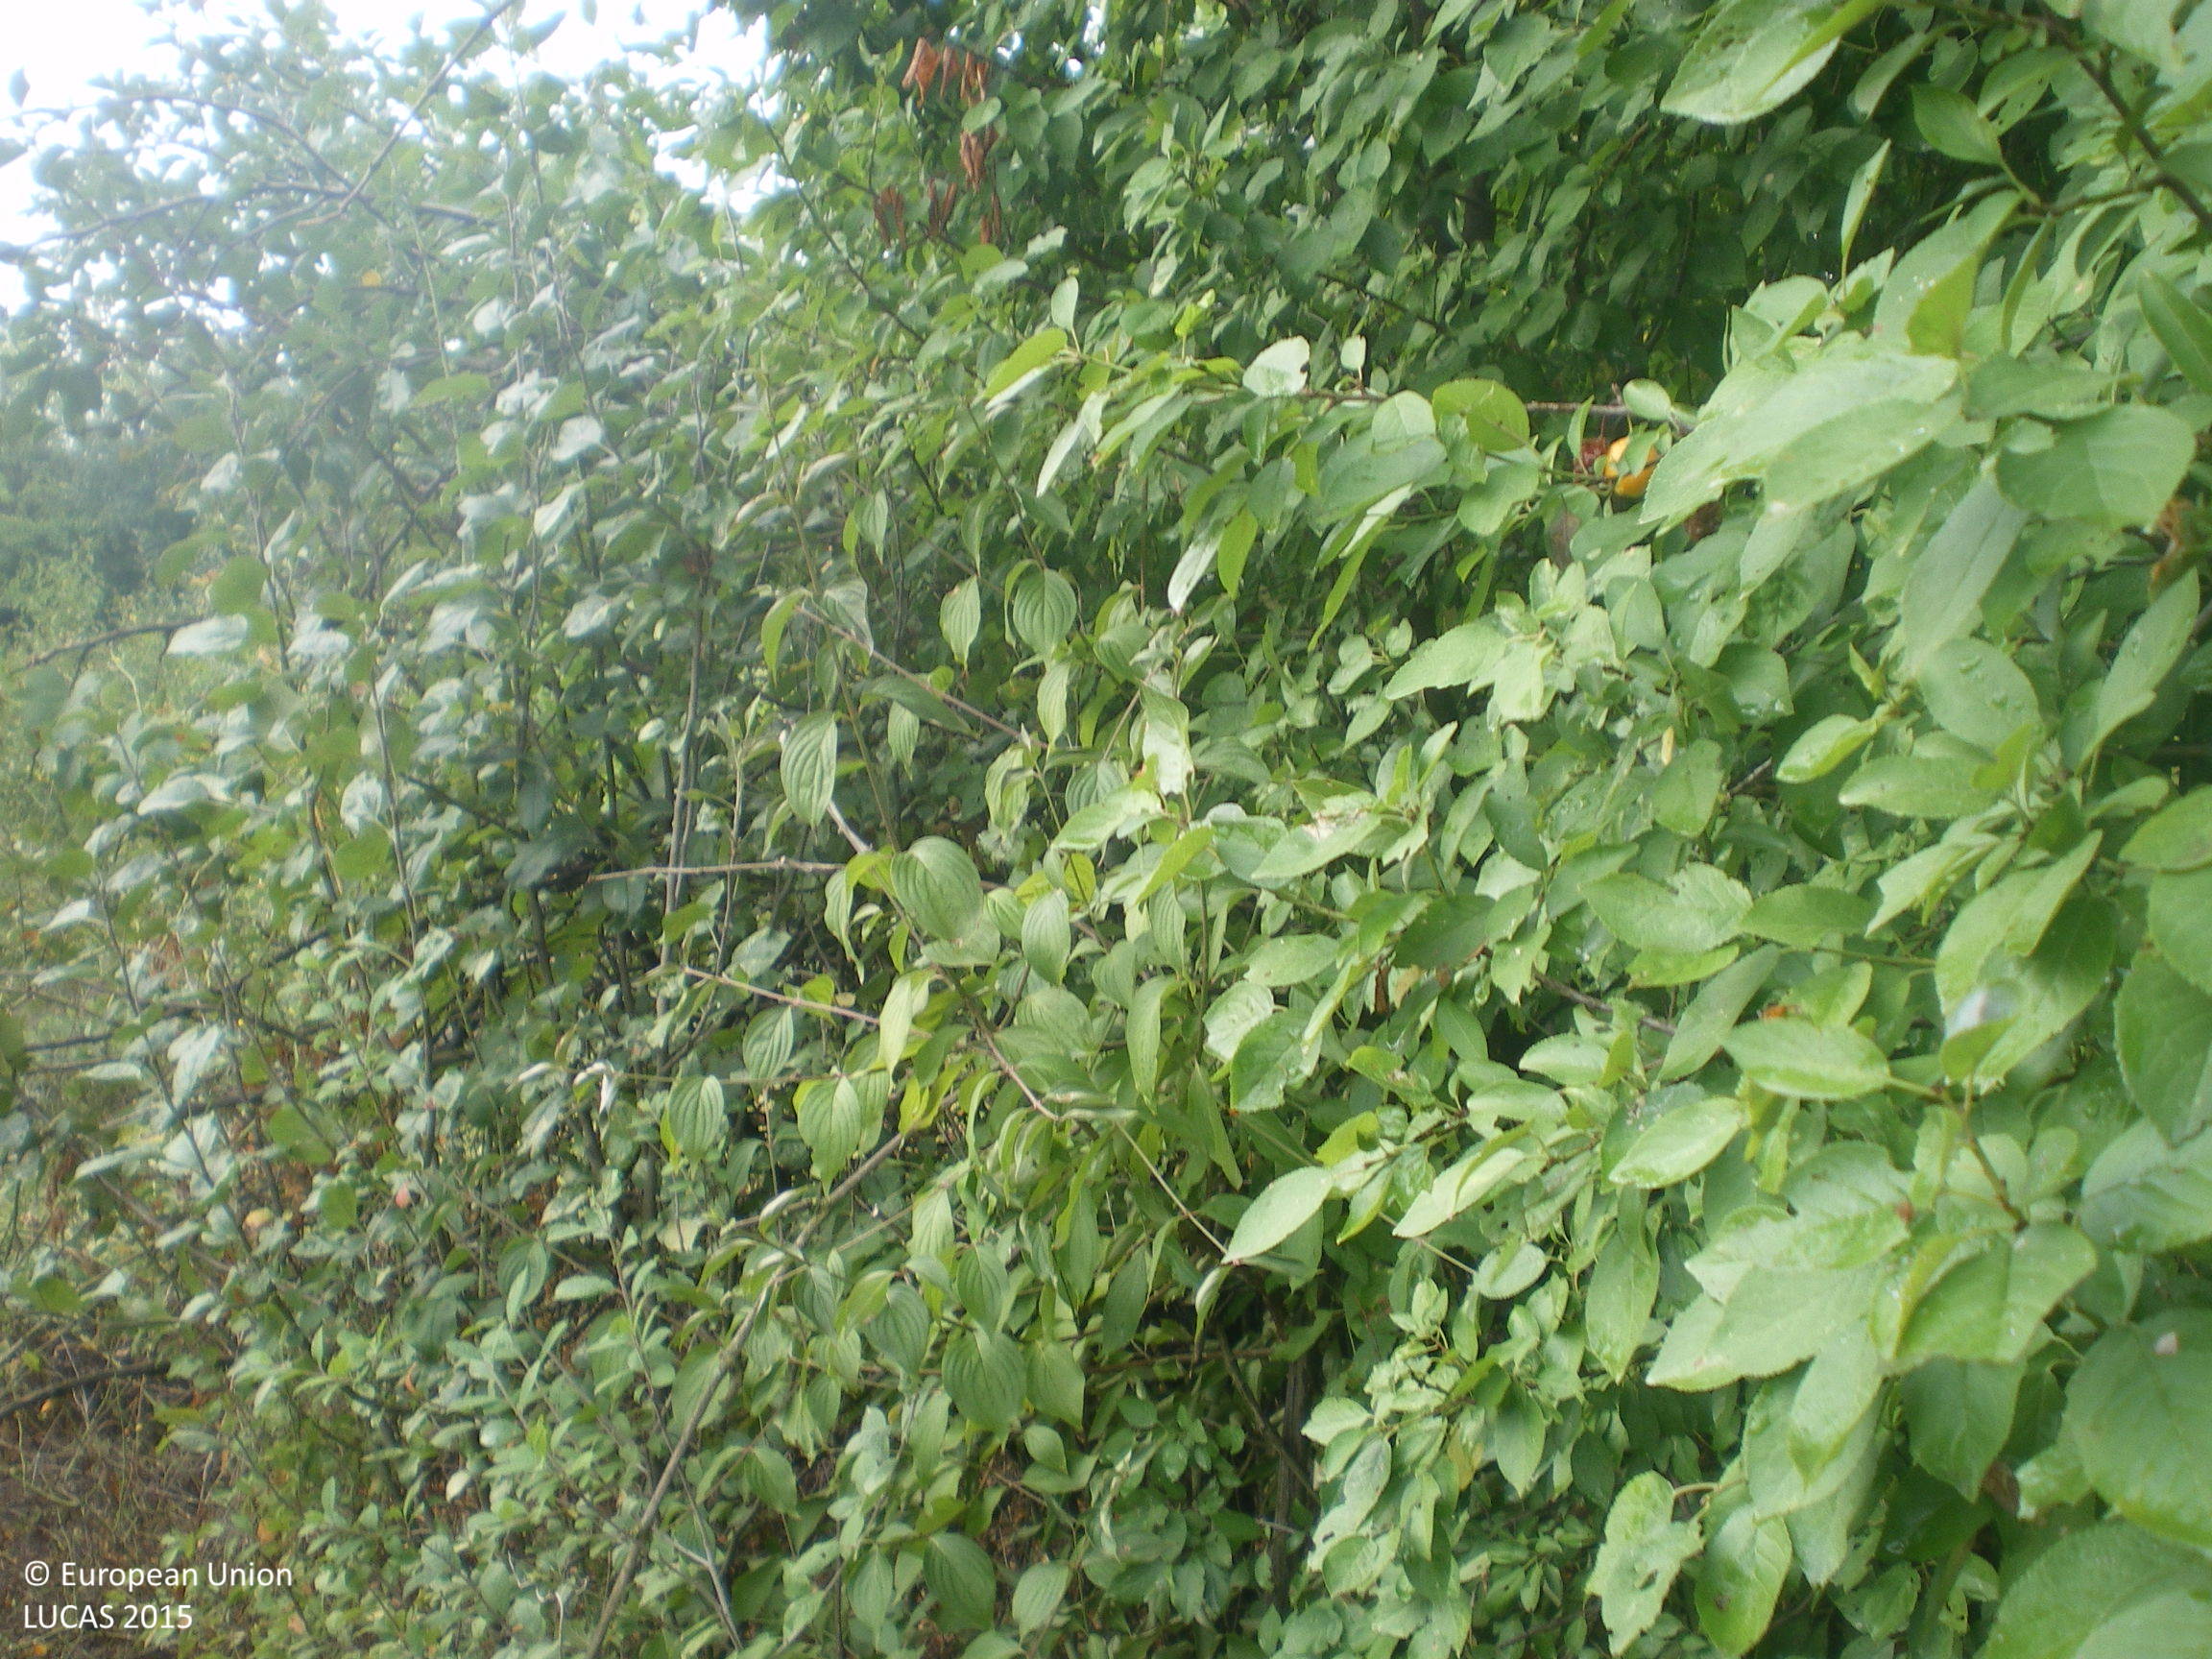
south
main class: Shrubland
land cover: Shrubland with sparse tree cover
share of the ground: 50 - 75 %
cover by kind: shrubs 55 %, herbaceous plants 40 %, broadleaved forest trees 5 %
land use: Fallow land
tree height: > 5 m
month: August
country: BG
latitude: 42.3022
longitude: 25.9312
